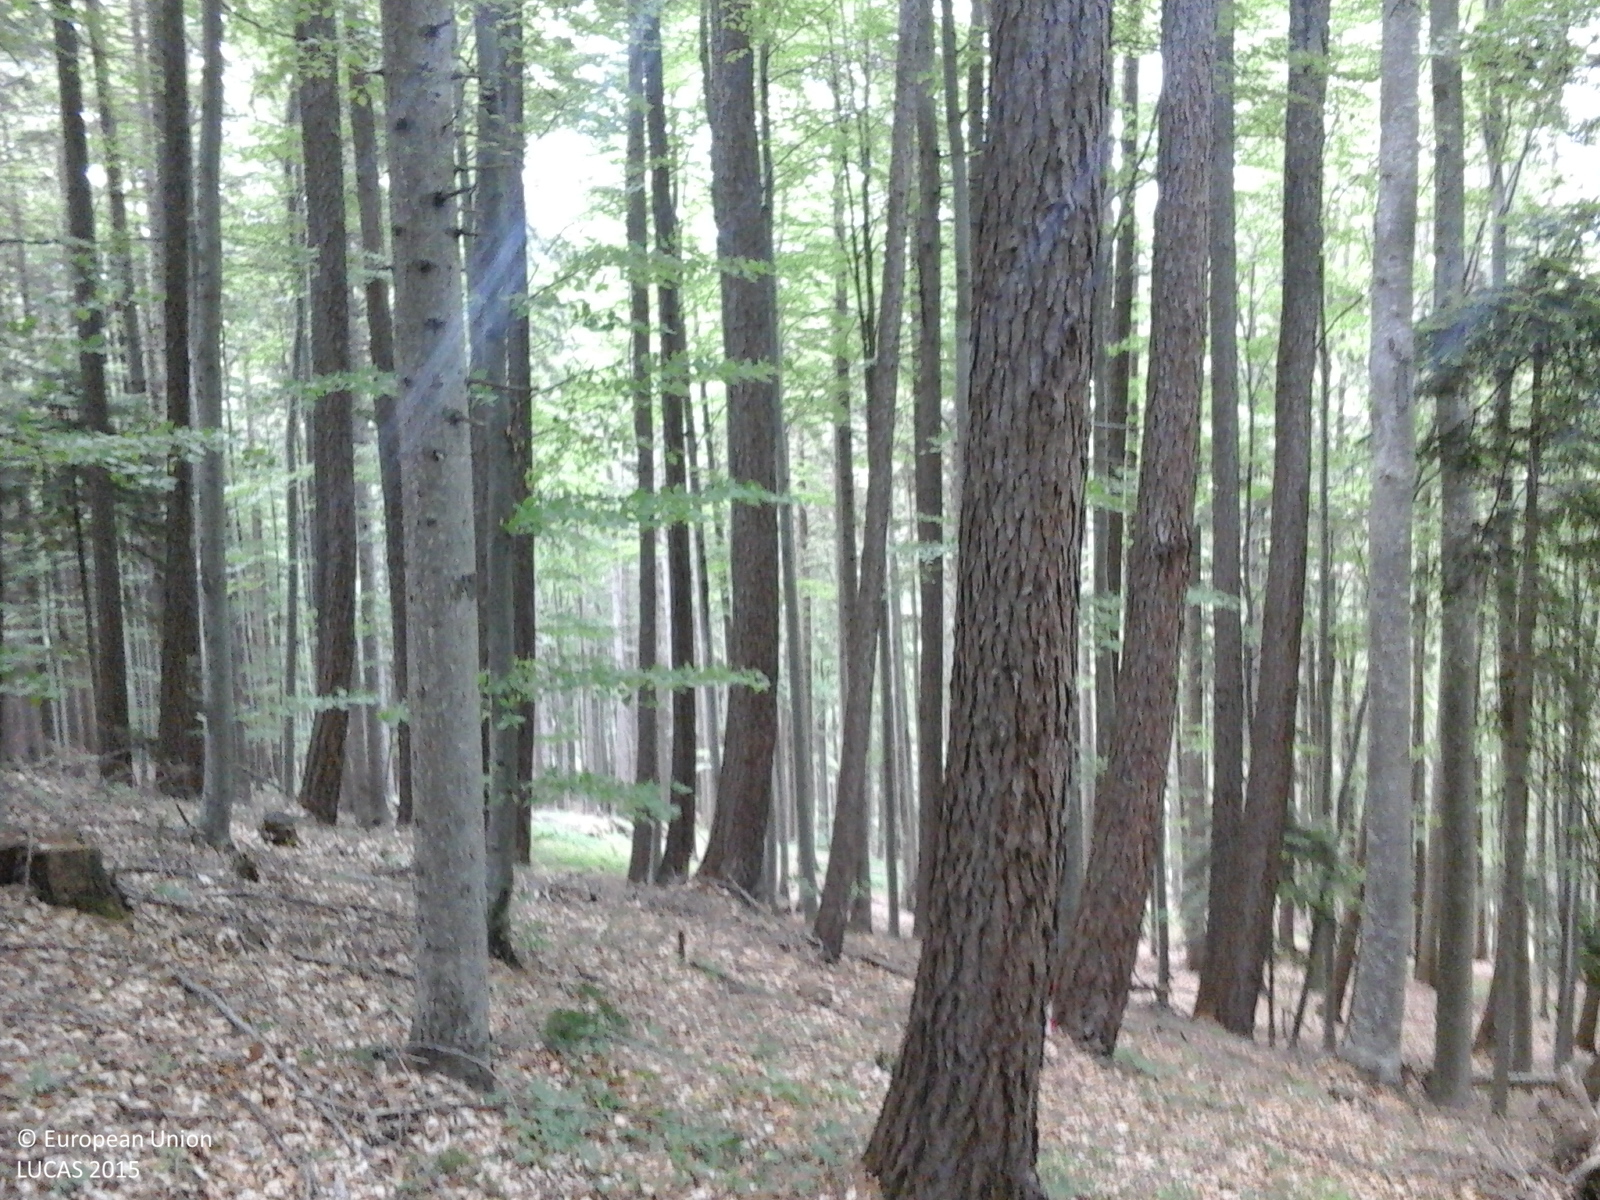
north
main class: Woodland
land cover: Other mixed woodland
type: alpine coniferous forest
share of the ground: > 75 %
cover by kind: coniferous forest trees 70 %, broadleaved forest trees 30 %
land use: Forestry
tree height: > 5 m
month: May
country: RO
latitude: 45.2553
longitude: 25.5829
